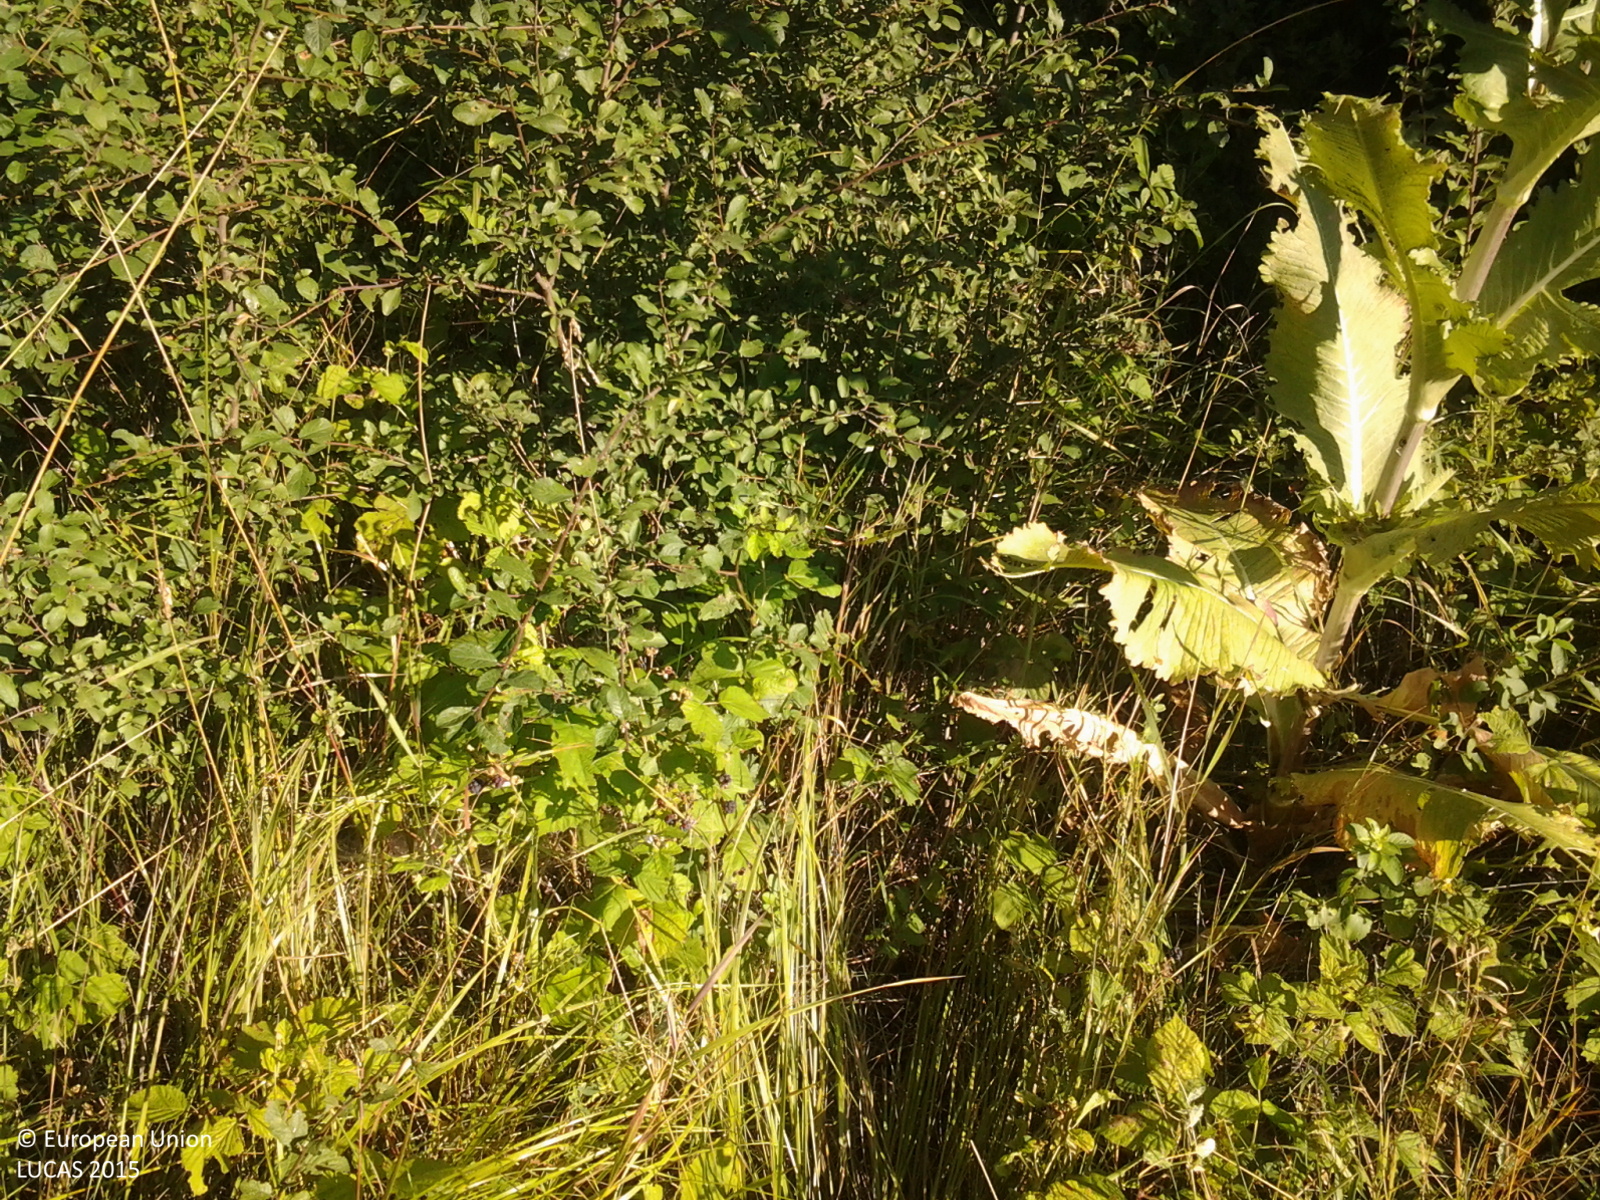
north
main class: Woodland
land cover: Broadleaved woodland
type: mesophytic deciduous forest
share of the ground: > 75 %
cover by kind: broadleaved forest trees 80 %, shrubs 10 %, herbaceous plants 10 %
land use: Forestry
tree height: > 5 m
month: July
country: HU
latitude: 46.7931
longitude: 21.2372
